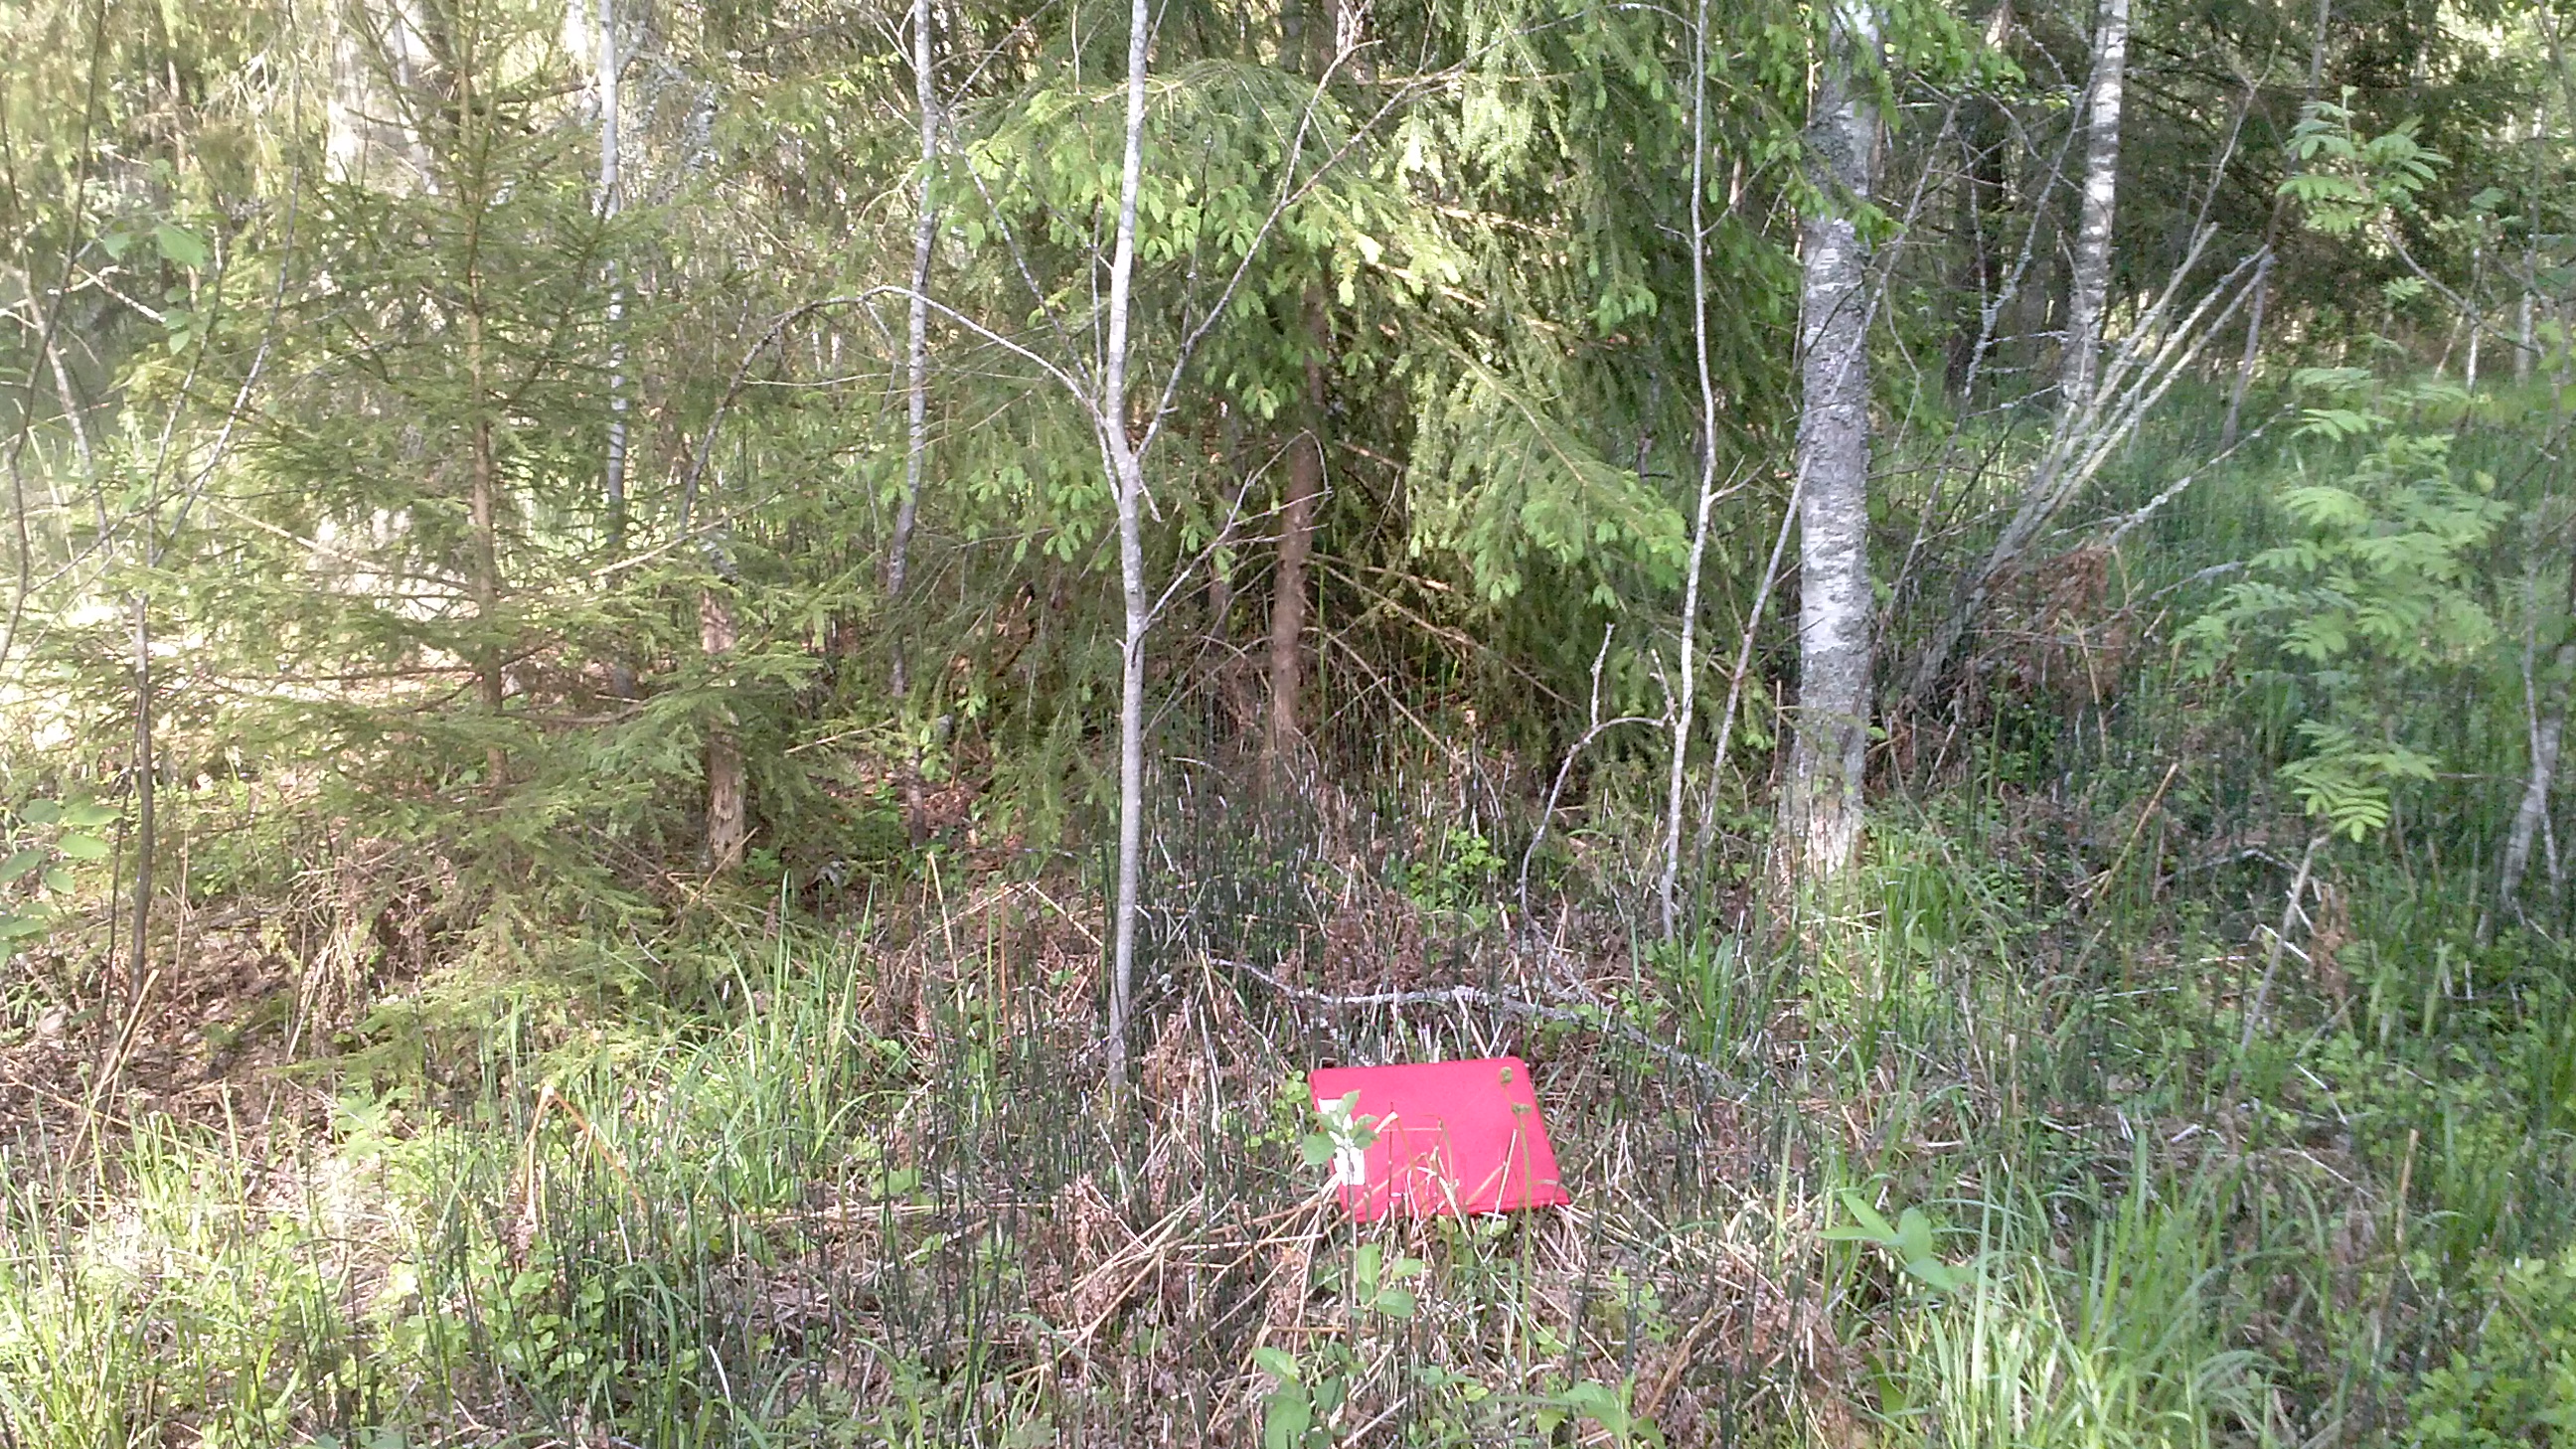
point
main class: Woodland
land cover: Spruce dominated mixed woodland
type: hemiboreal forest and nemoral coniferous forest and mixed broadleaved-coniferous forest
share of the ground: > 75 %
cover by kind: coniferous forest trees 60 %, broadleaved forest trees 25 %, herbaceous plants 15 %
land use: Forestry
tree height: > 5 m
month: May
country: LV
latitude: 56.3834
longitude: 27.2917
